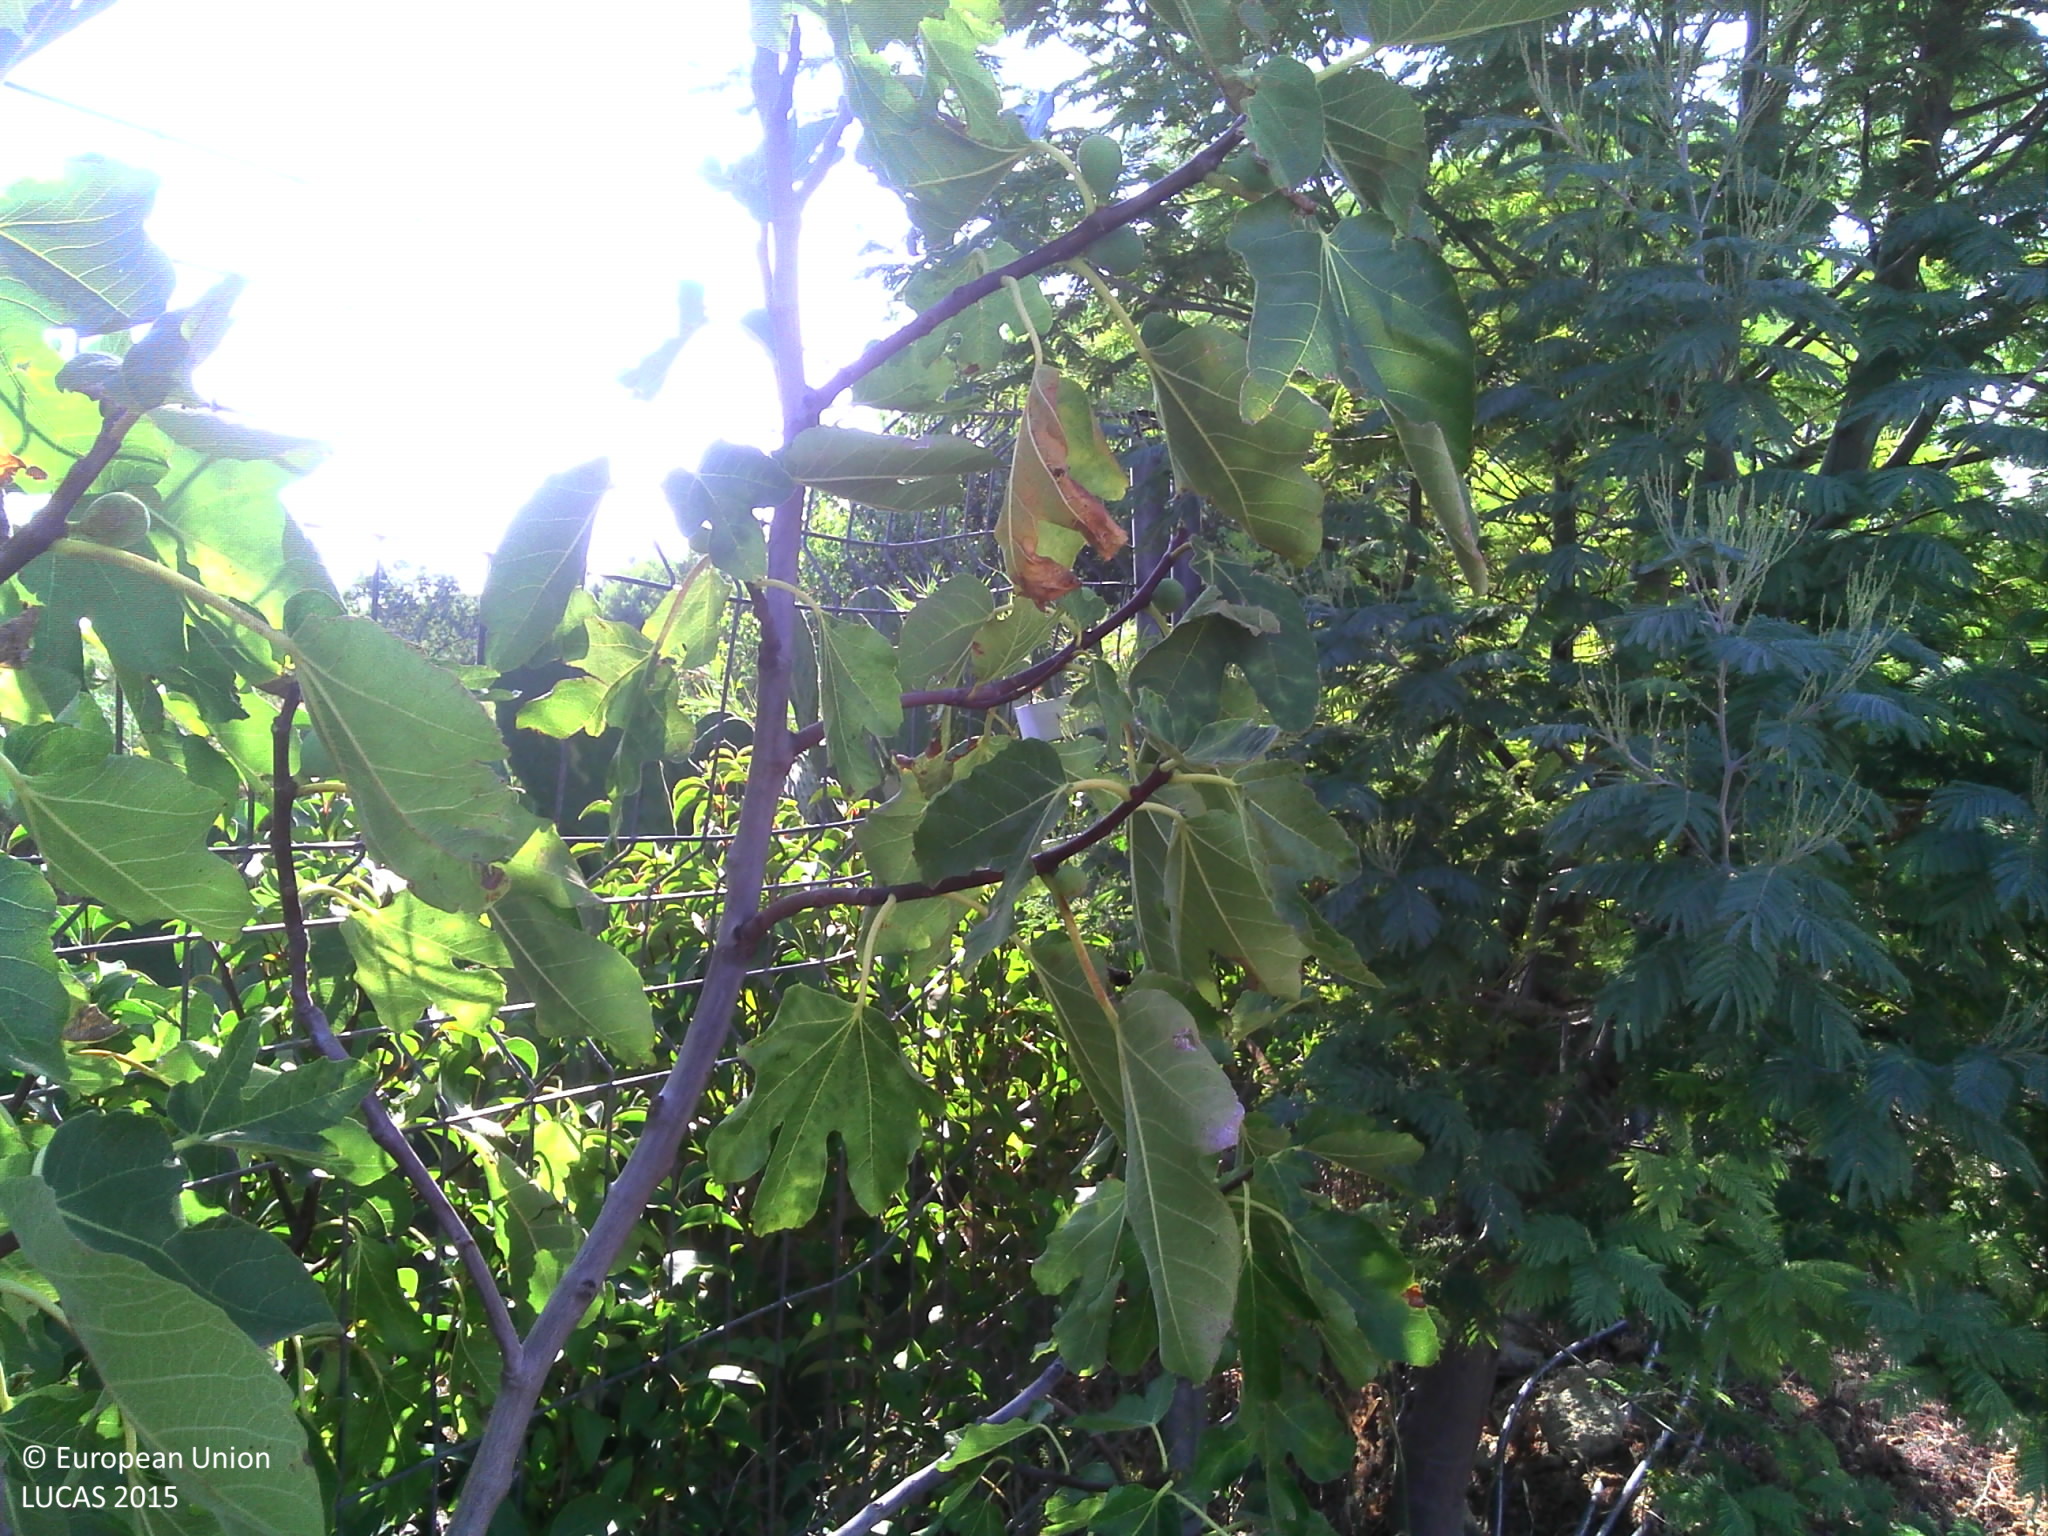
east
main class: Woodland
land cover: Broadleaved woodland
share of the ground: > 75 %
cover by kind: herbaceous plants 50 %, unconsolidated bare surface 25 %, broadleaved forest trees 20 %, shrubs 5 %
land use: Agriculture (excluding fallow land and kitchen gardens)
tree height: < 5 m
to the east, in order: Broadleaved woodland; Fences; Broadleaved woodland; Other bare soil; Broadleaved woodland; Shrubland without tree cover; Shrubland with sparse tree cover; Grassland without tree/shrub cover; Lines of trees; Grassland without tree/shrub cover; Lines of trees
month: July
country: FR
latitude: 42.6387
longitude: 2.8778
